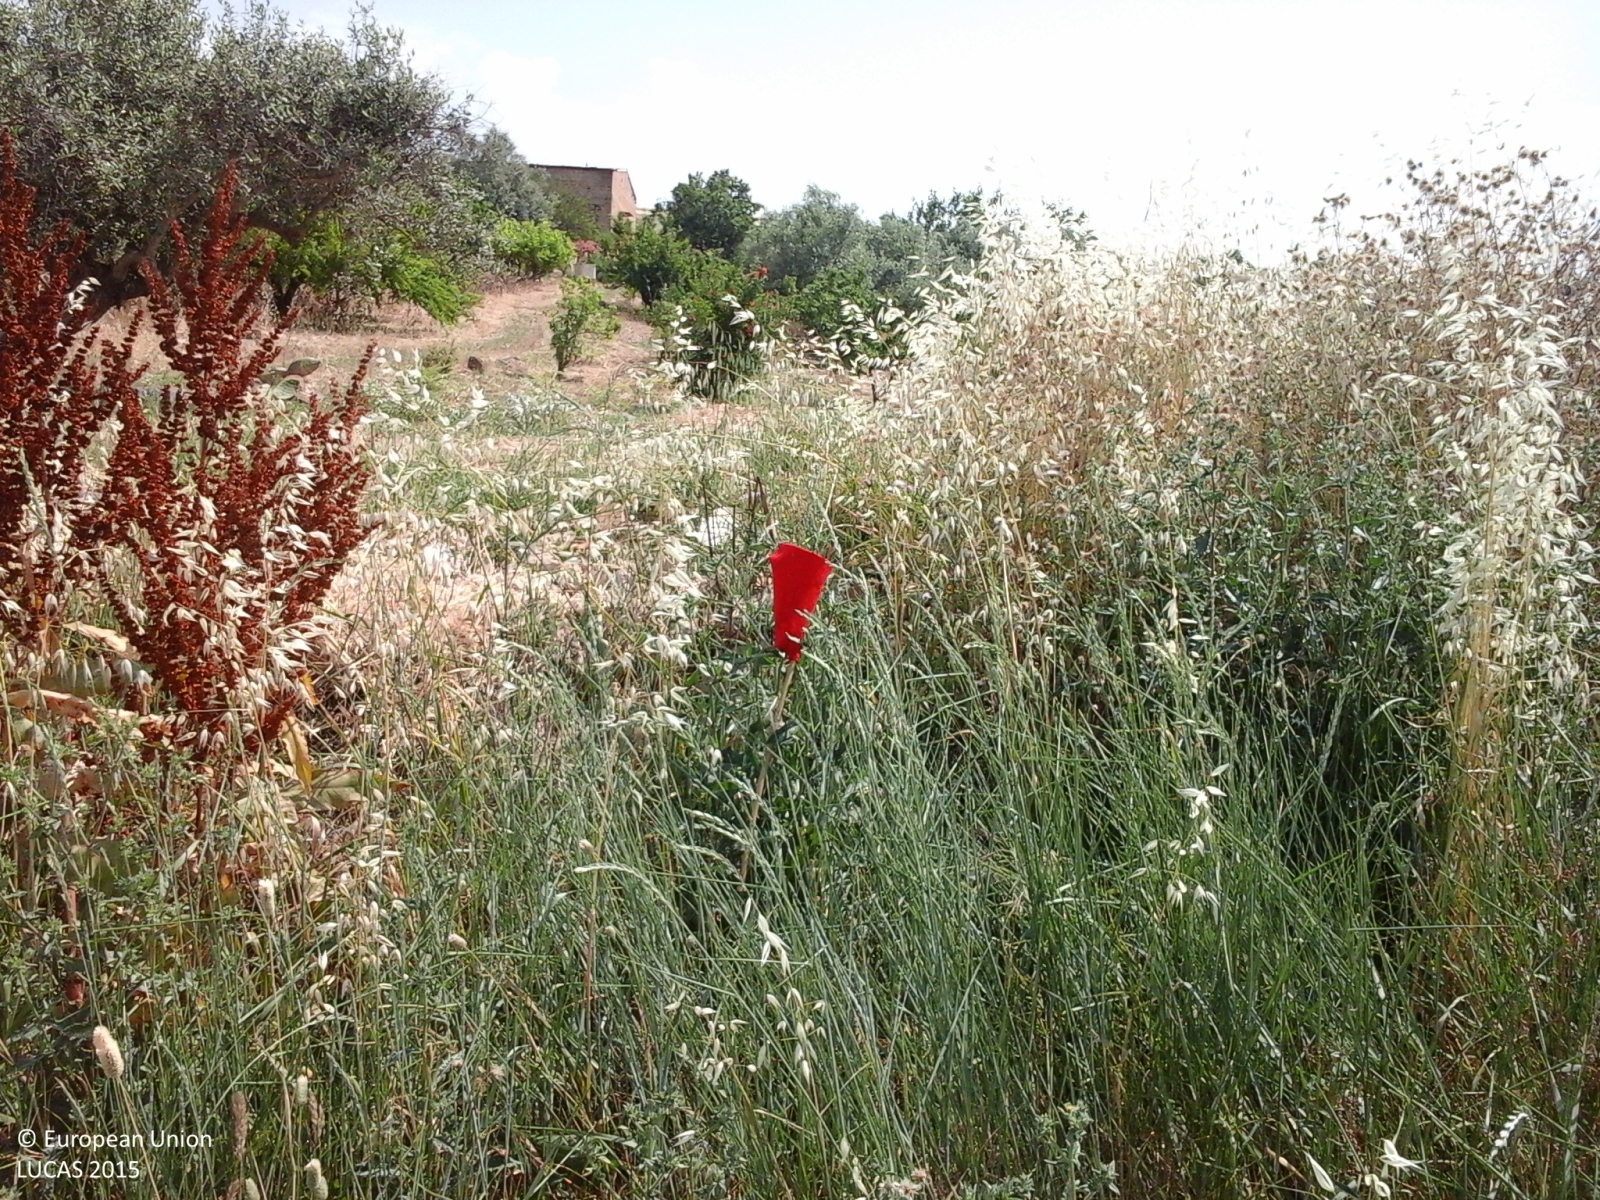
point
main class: Grassland
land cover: Grassland without tree/shrub cover
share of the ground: > 75 %
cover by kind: herbaceous plants 100 %
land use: Semi-natural and natural areas not in use
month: June
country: IT
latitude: 37.3385
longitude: 13.4832
